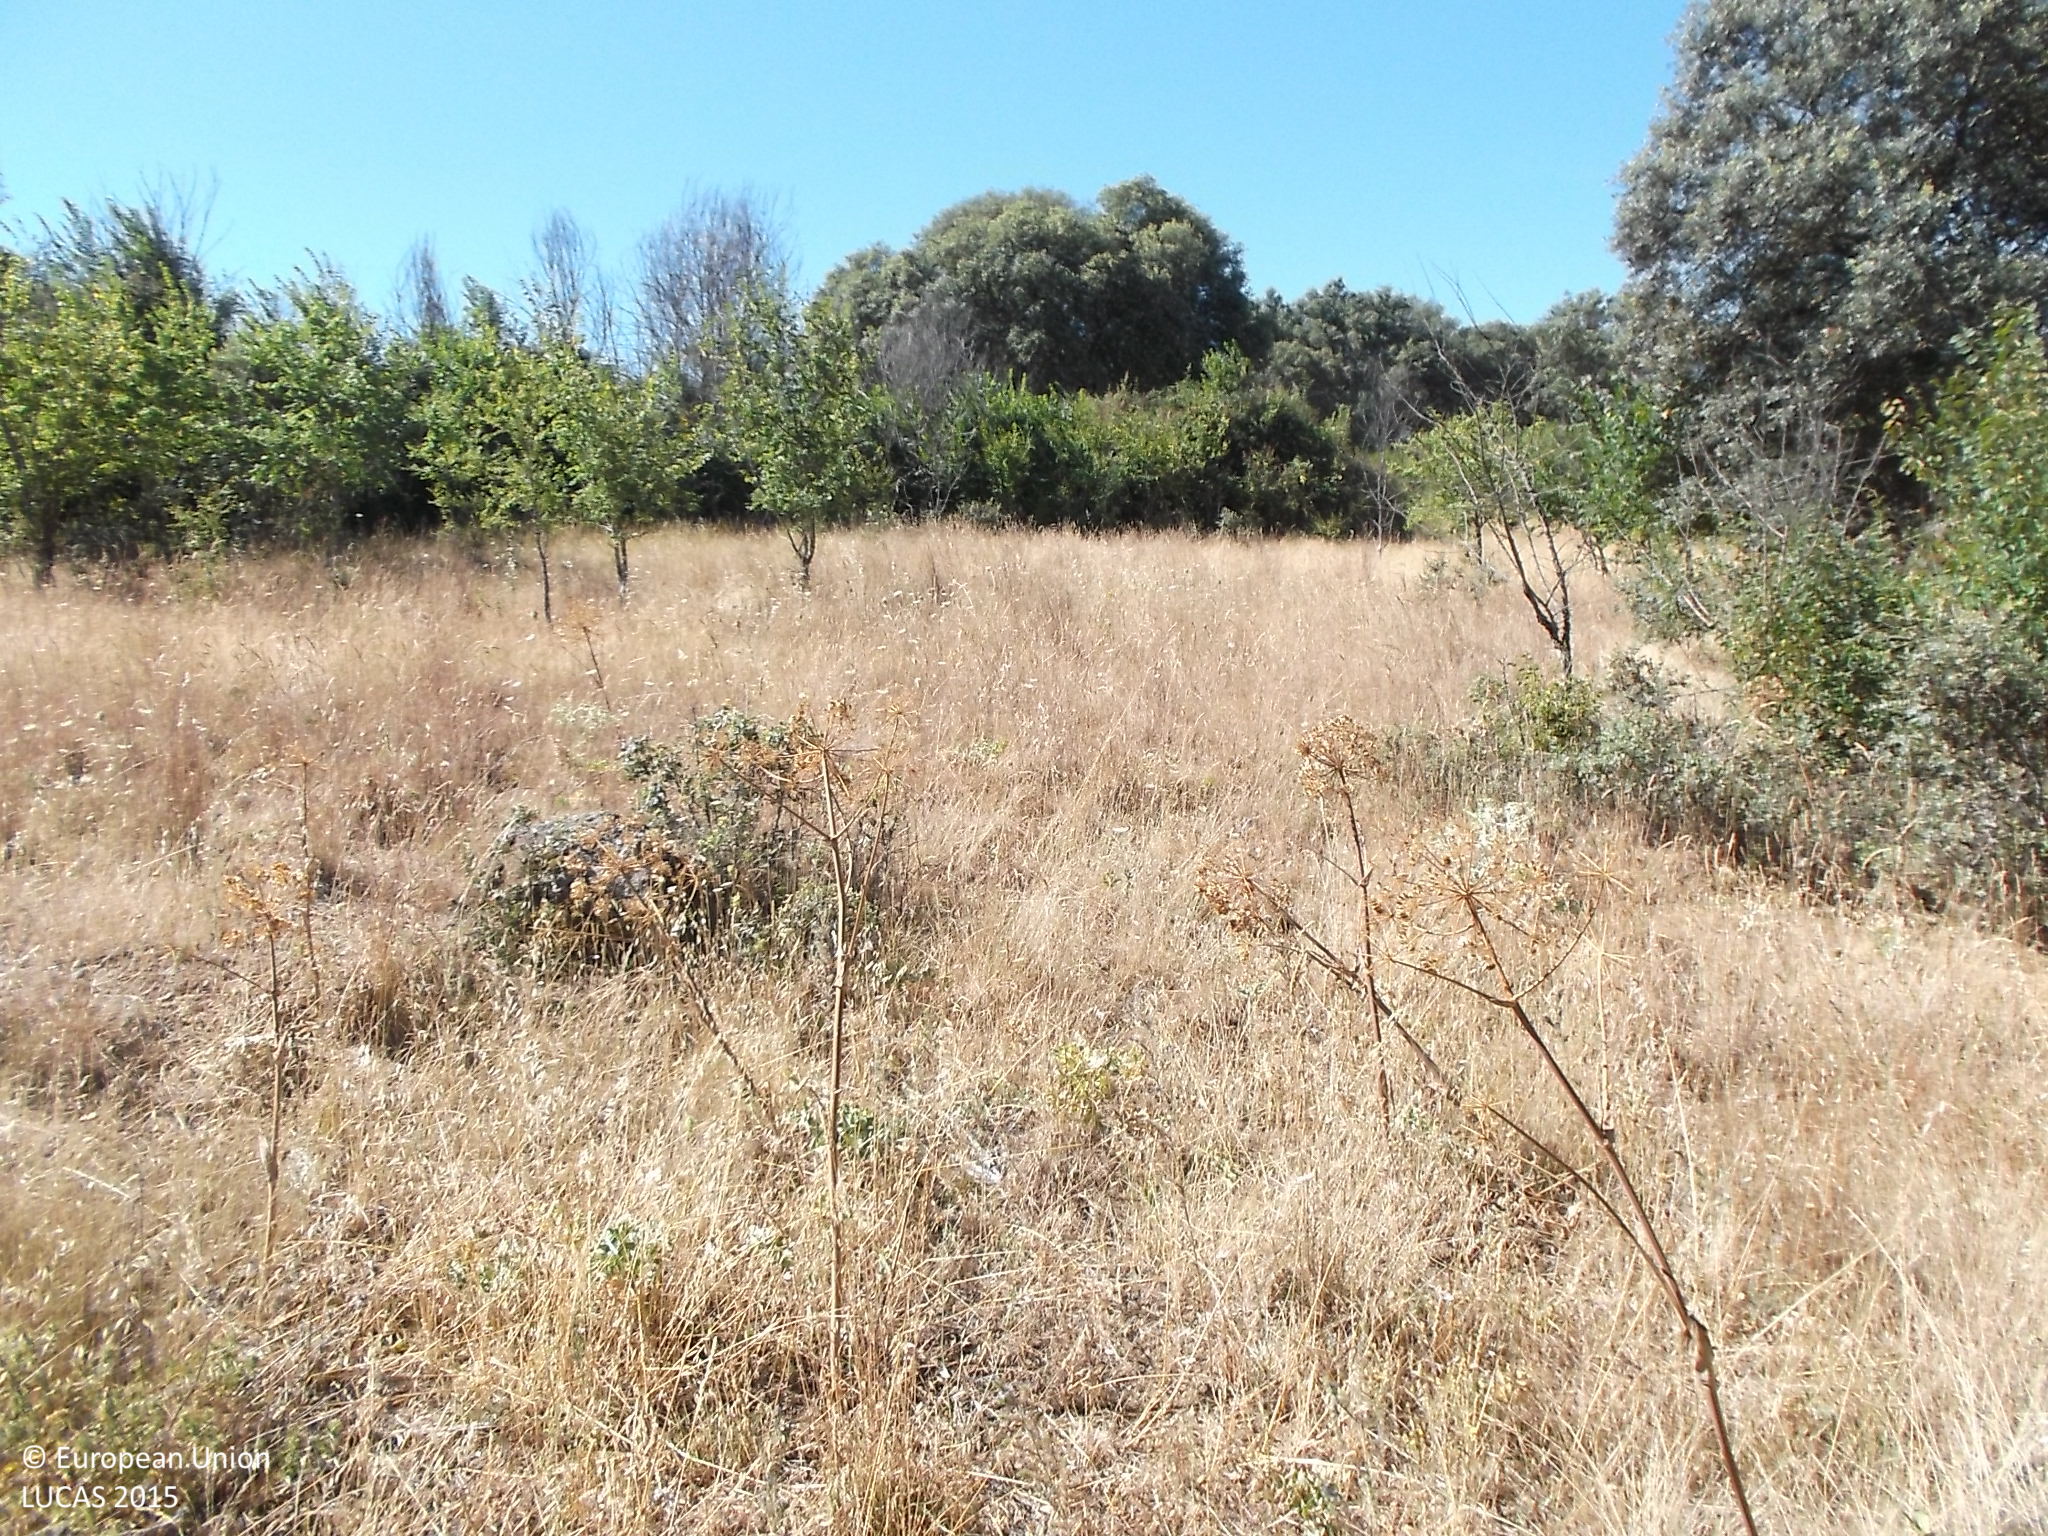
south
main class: Grassland
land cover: Grassland with sparse tree/shrub cover
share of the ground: > 75 %
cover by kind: herbaceous plants 90 %, broadleaved forest trees 5 %, shrubs 5 %
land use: Agriculture (excluding fallow land and kitchen gardens)
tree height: > 5 m
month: July
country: ES
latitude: 41.5014
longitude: -6.1110
